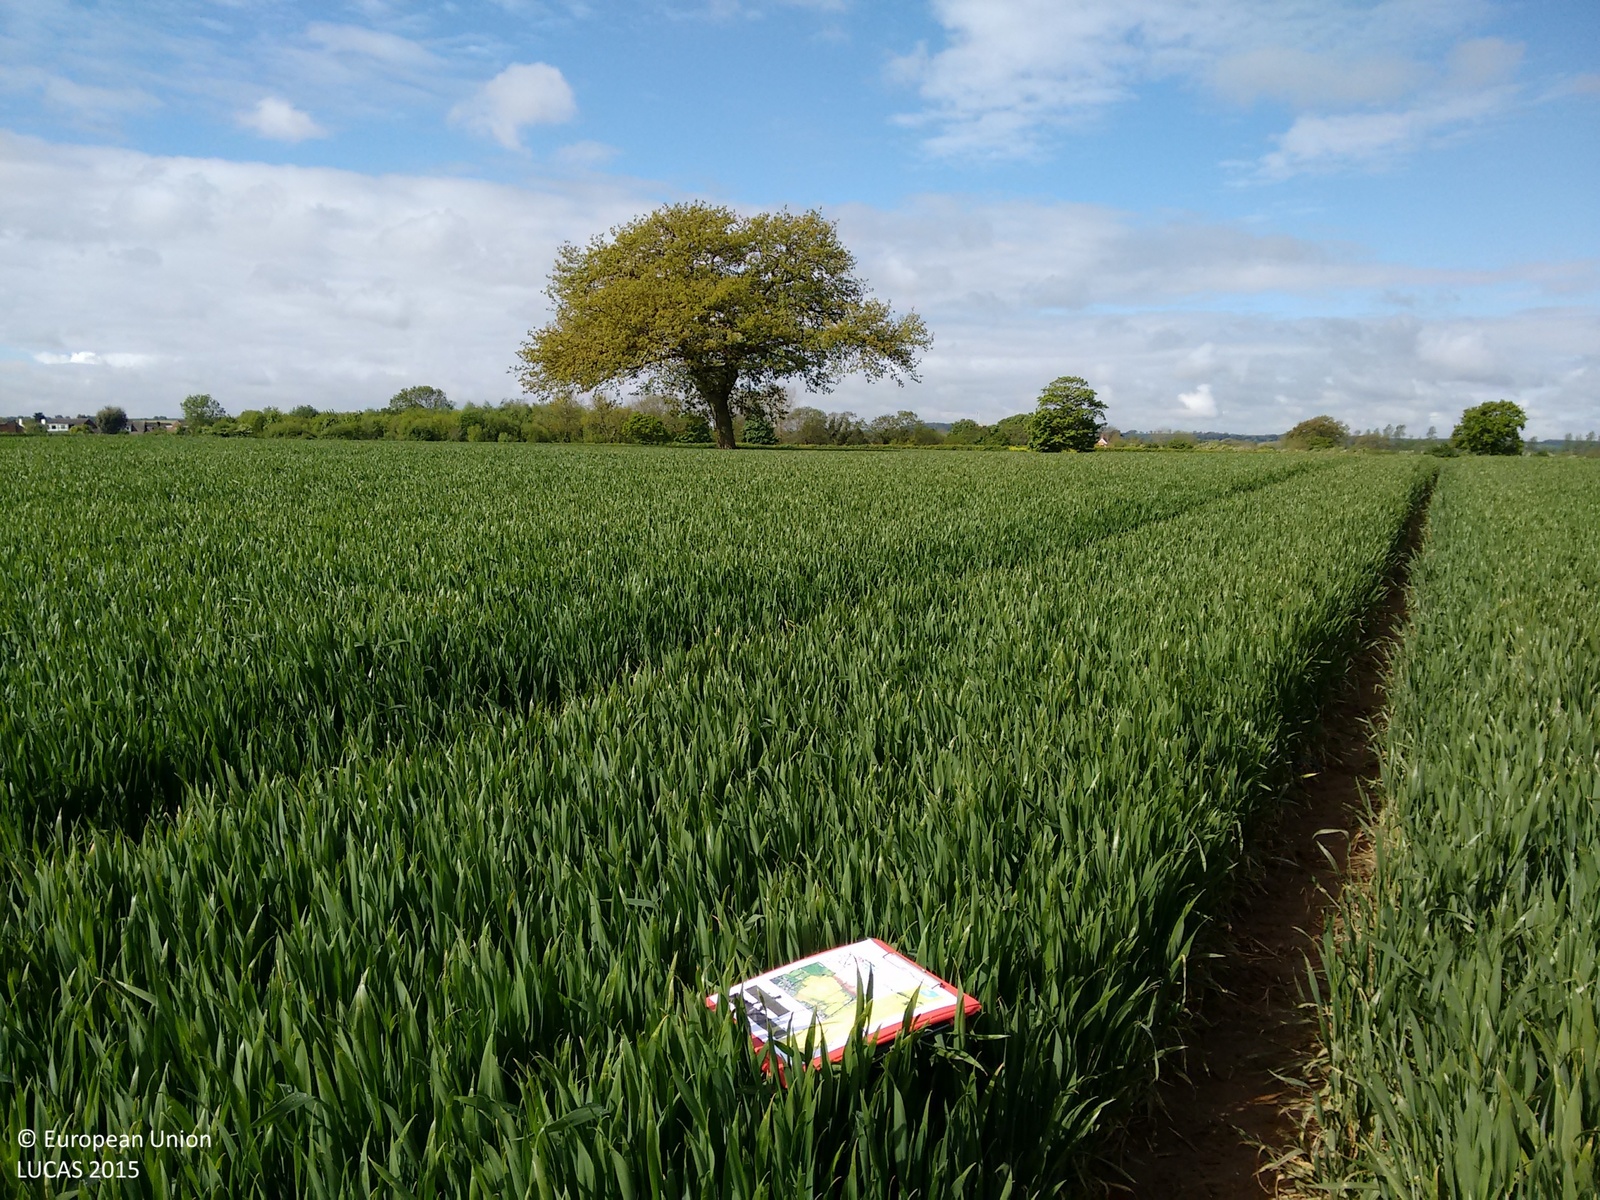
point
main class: Cropland
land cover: Common wheat
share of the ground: > 75 %
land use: Agriculture (excluding fallow land and kitchen gardens)
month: May
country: GB
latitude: 53.4721
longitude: -0.0508
